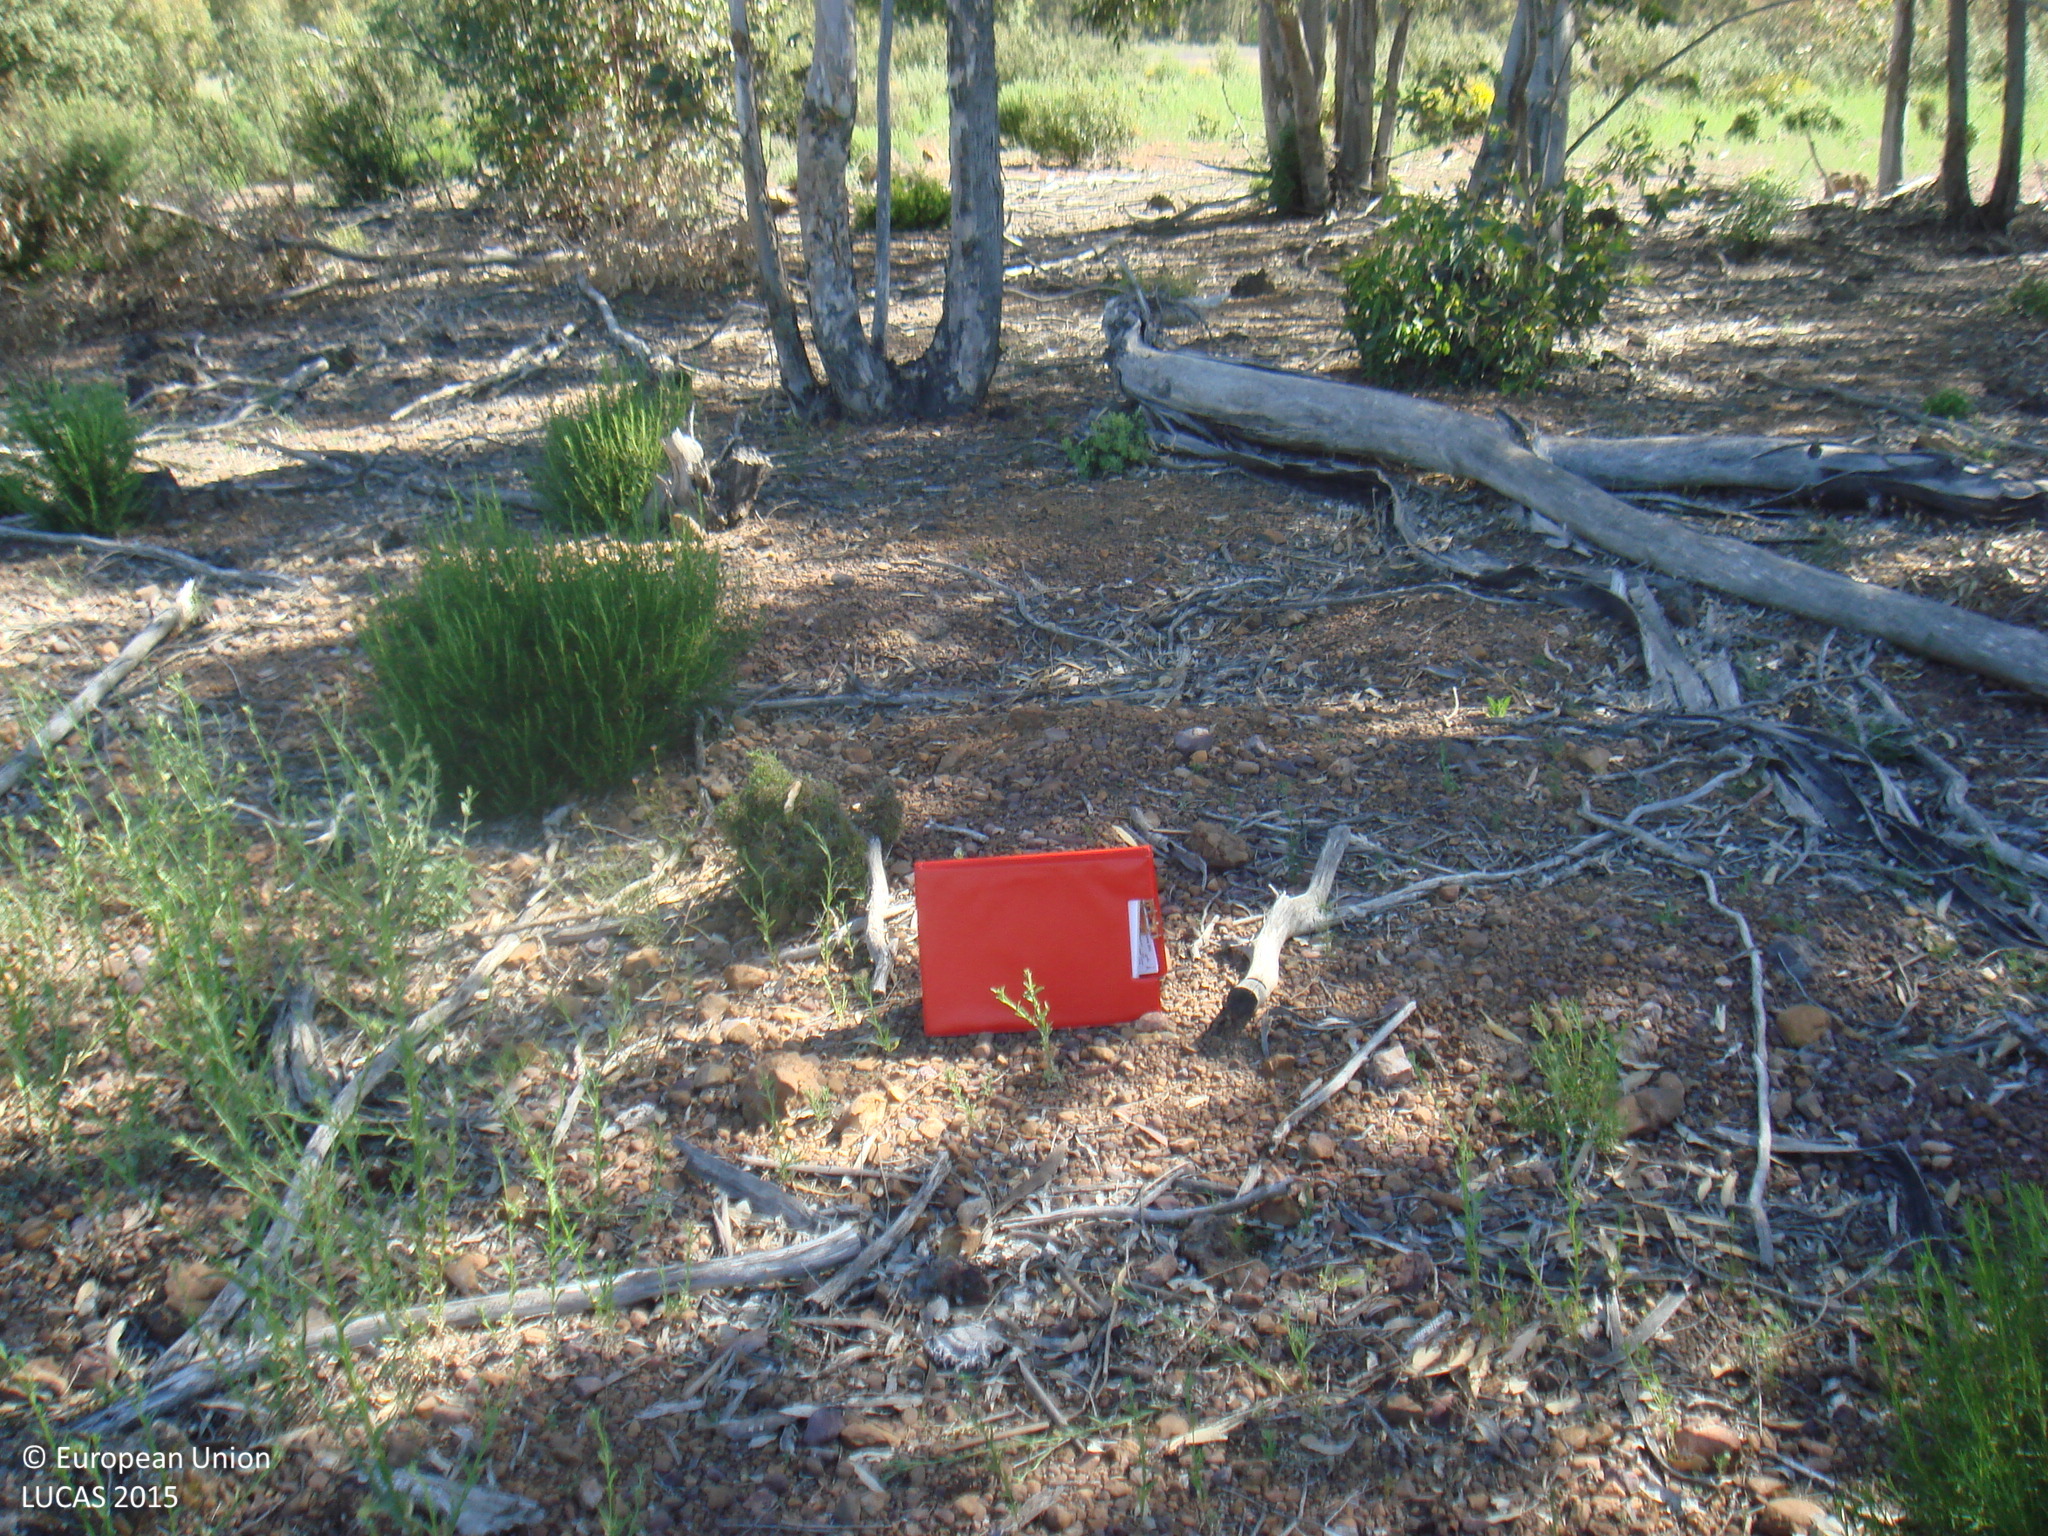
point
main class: Woodland
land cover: Broadleaved woodland
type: broadleaved evergreen forest
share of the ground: > 75 %
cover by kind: broadleaved forest trees 50 %, herbaceous plants 30 %, shrubs 20 %
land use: Forestry
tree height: > 5 m
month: May
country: ES
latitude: 38.4575
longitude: -4.4468
